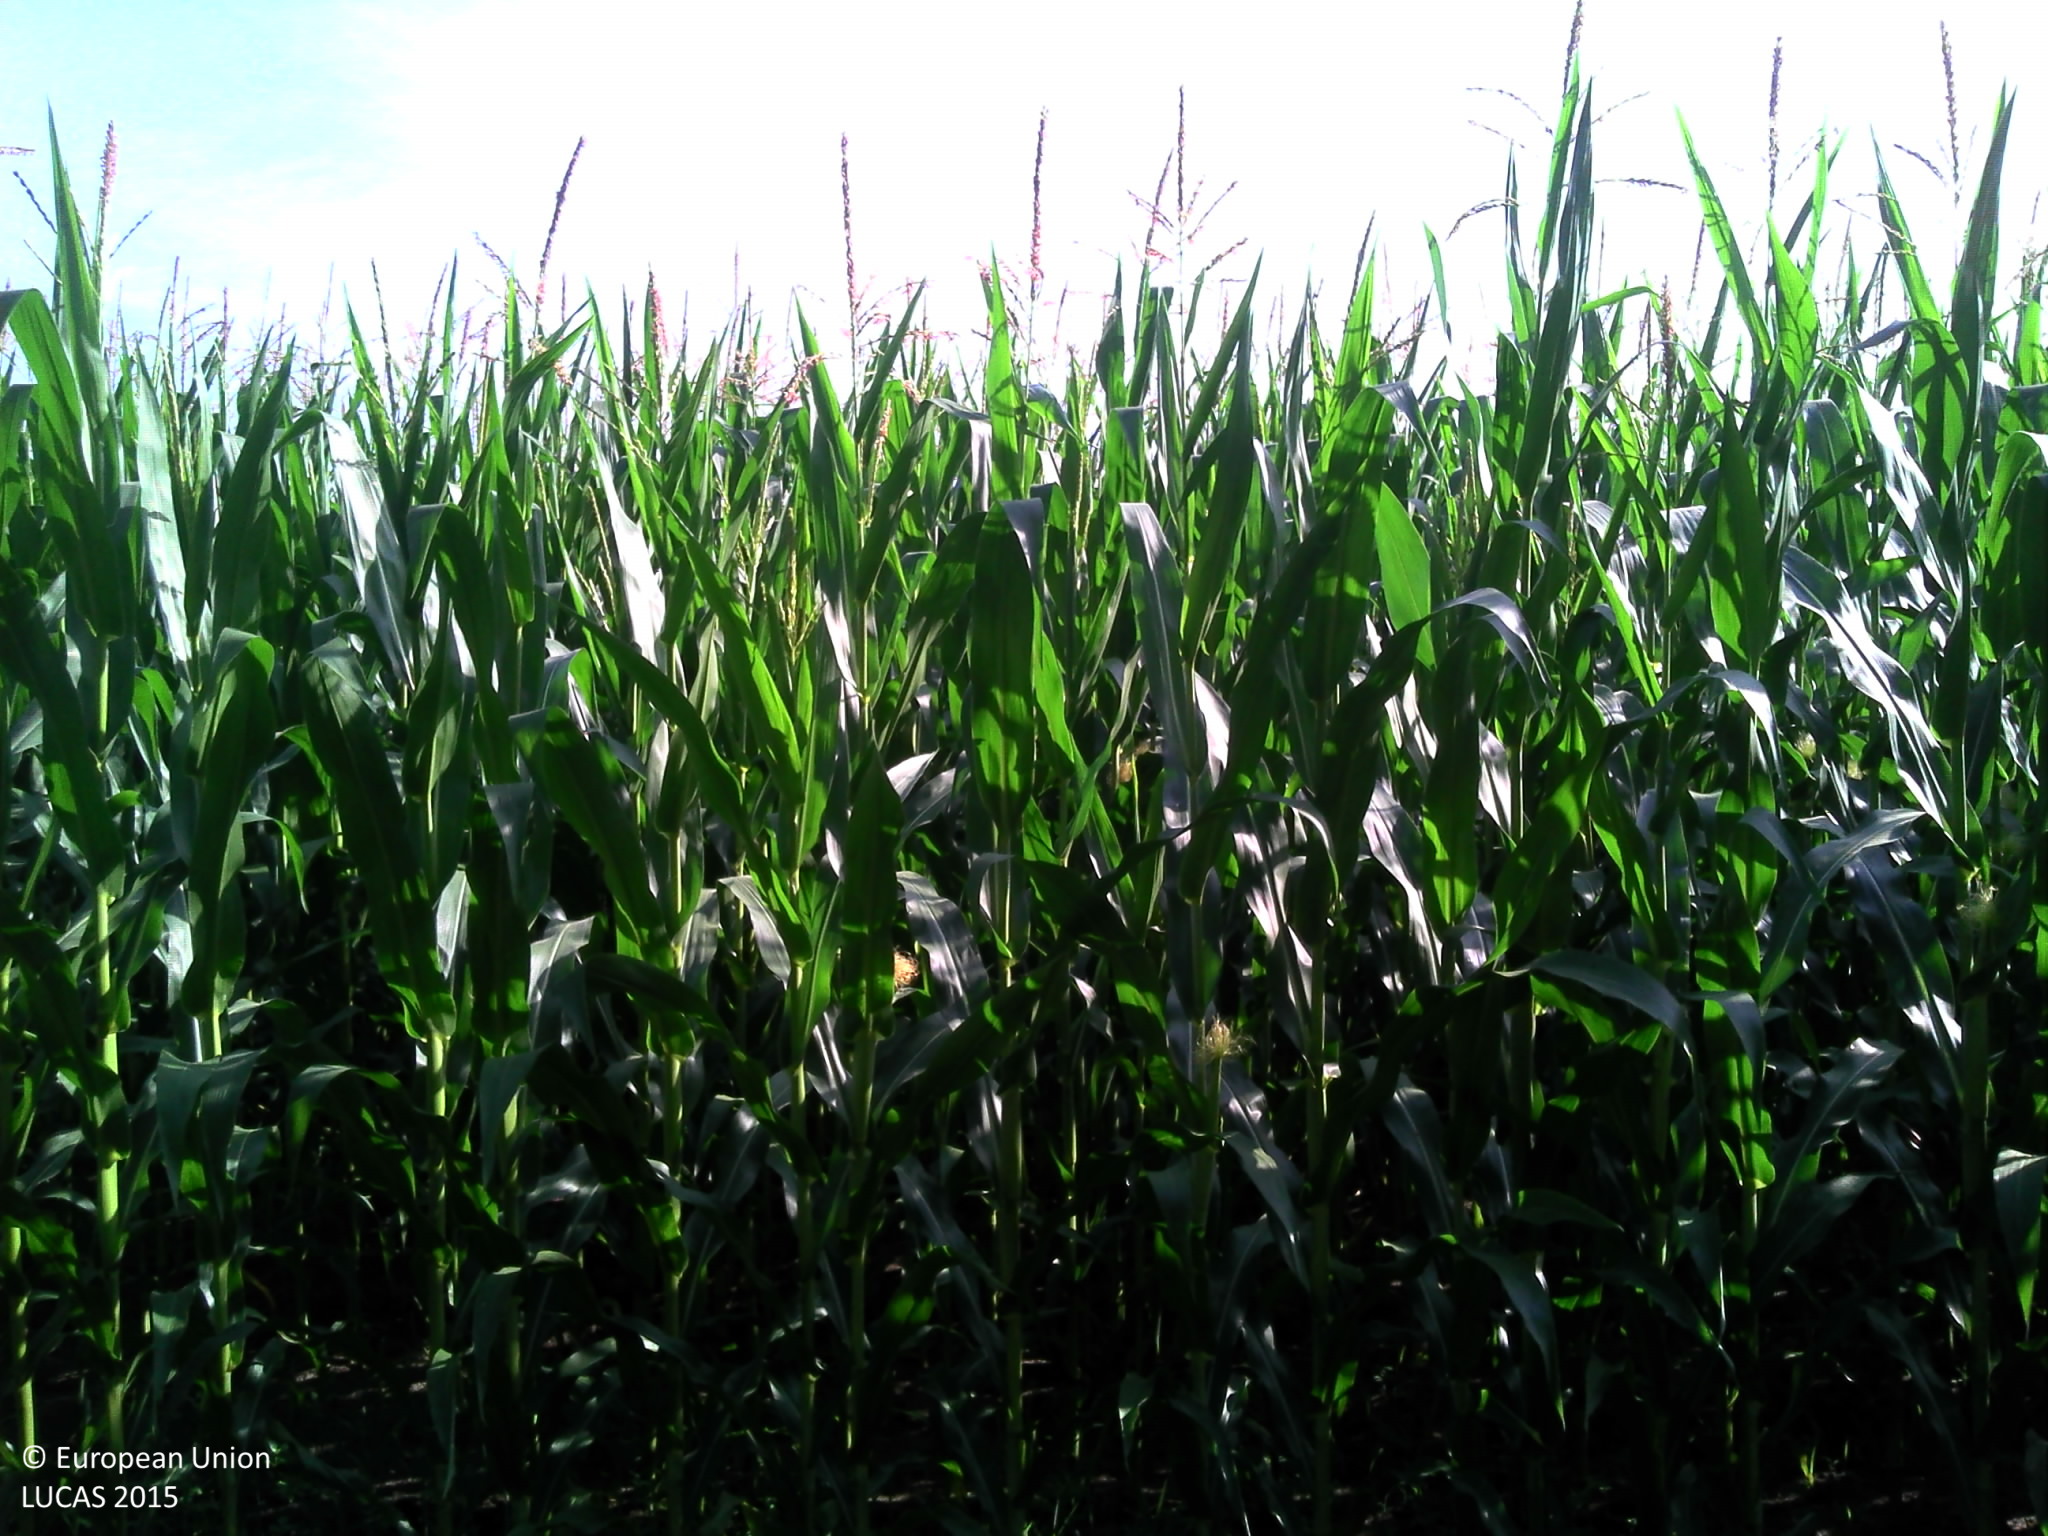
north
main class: Woodland
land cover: Broadleaved woodland
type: thermophilous deciduous forest
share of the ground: 50 - 75 %
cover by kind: broadleaved forest trees 75 %, herbaceous plants 15 %, coniferous forest trees 10 %
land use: Forestry
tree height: > 5 m
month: July
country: FR
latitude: 44.1281
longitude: -0.6504
